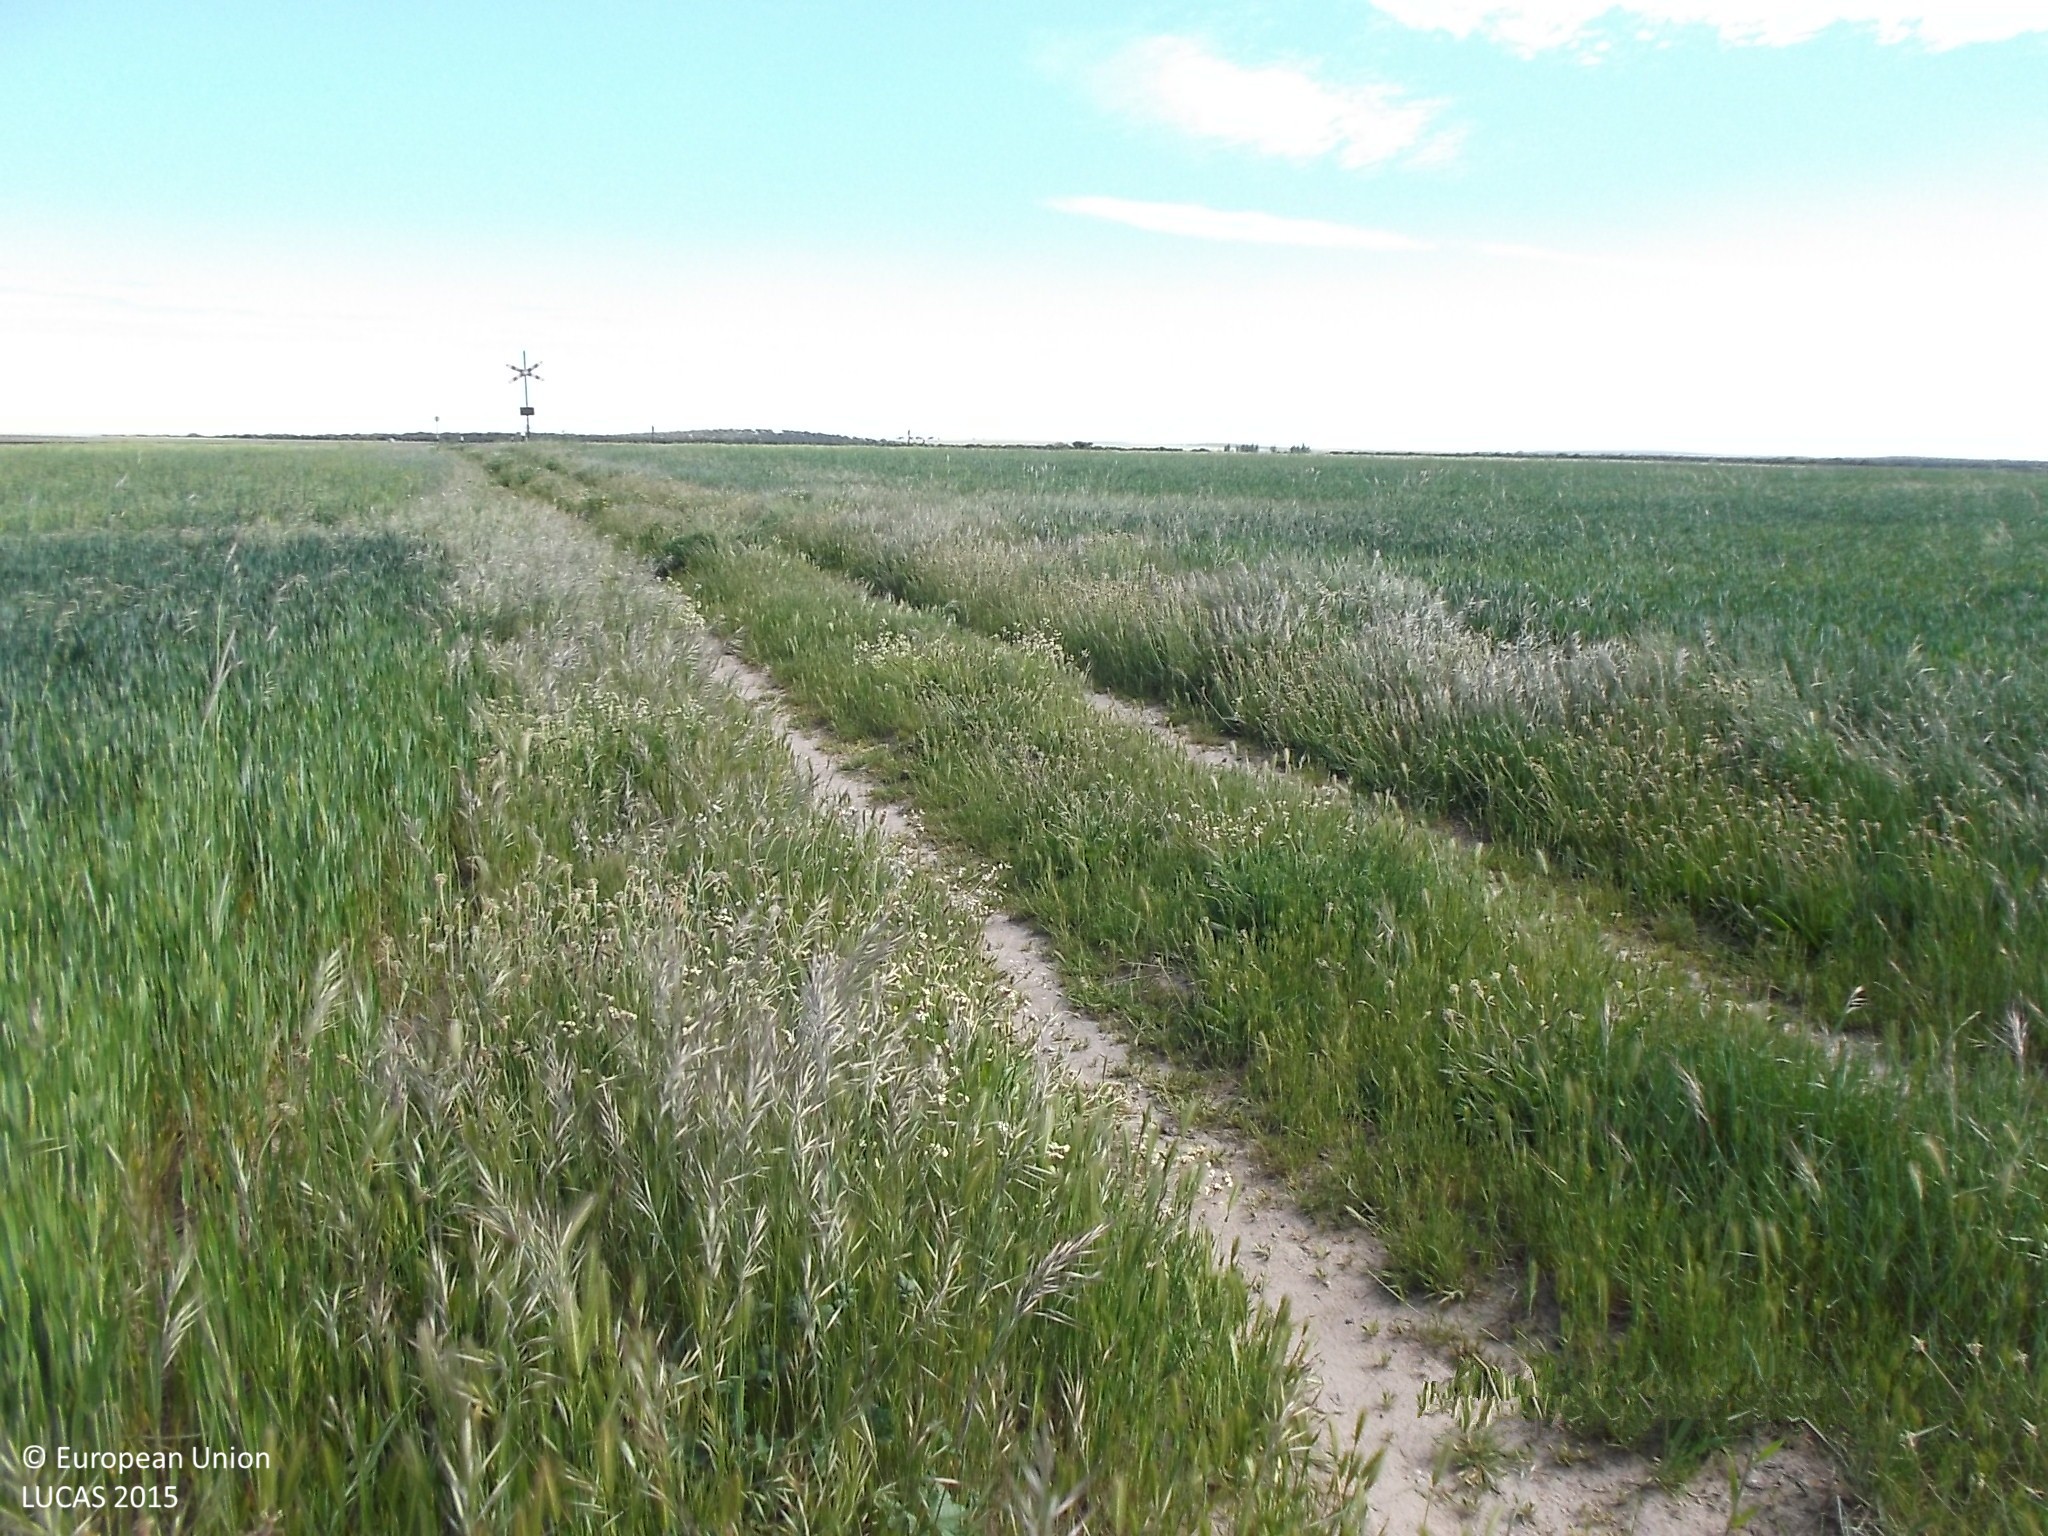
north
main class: Cropland
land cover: Common wheat
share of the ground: > 75 %
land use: Agriculture (excluding fallow land and kitchen gardens)
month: May
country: ES
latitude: 40.8034
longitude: -6.2185
